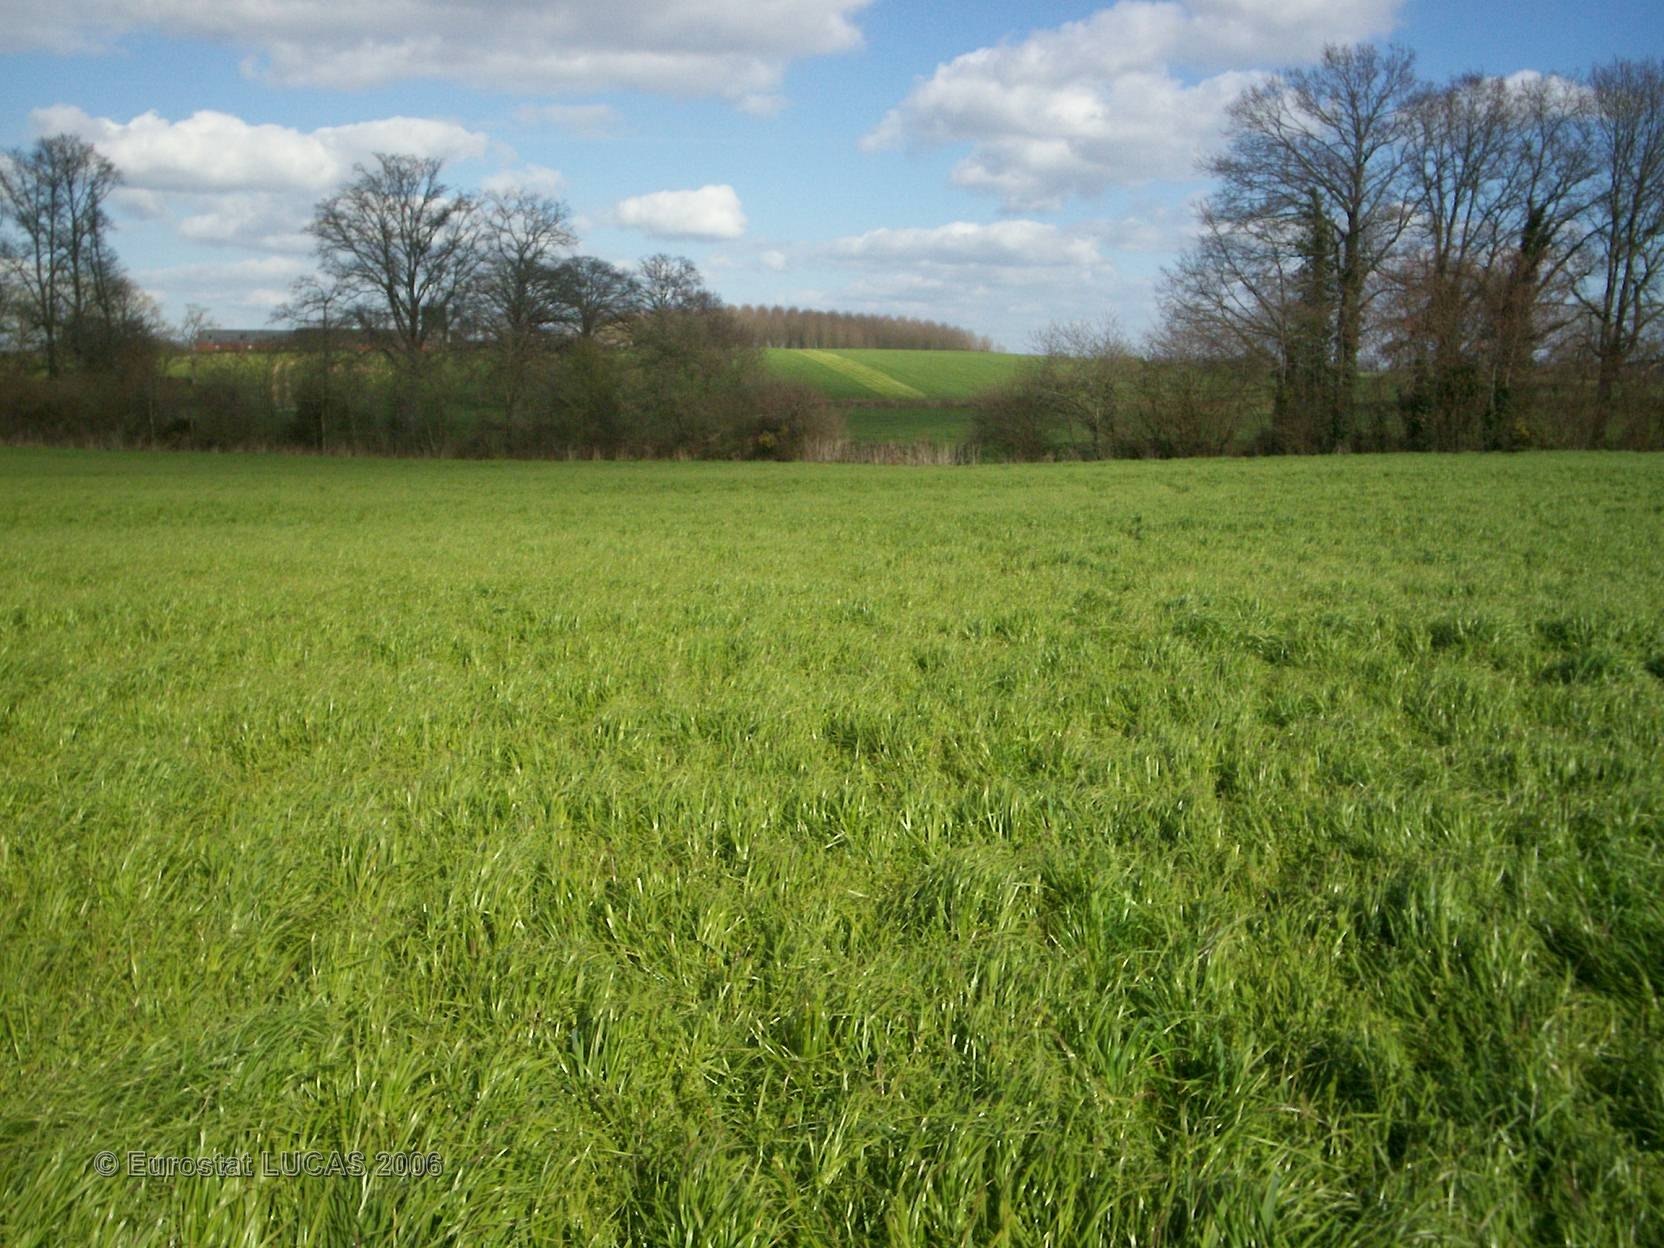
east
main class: Grassland
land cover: Grassland without tree/shrub cover
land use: Agriculture (excluding fallow land and kitchen gardens)
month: April
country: FR
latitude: 48.0023
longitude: -1.3148
